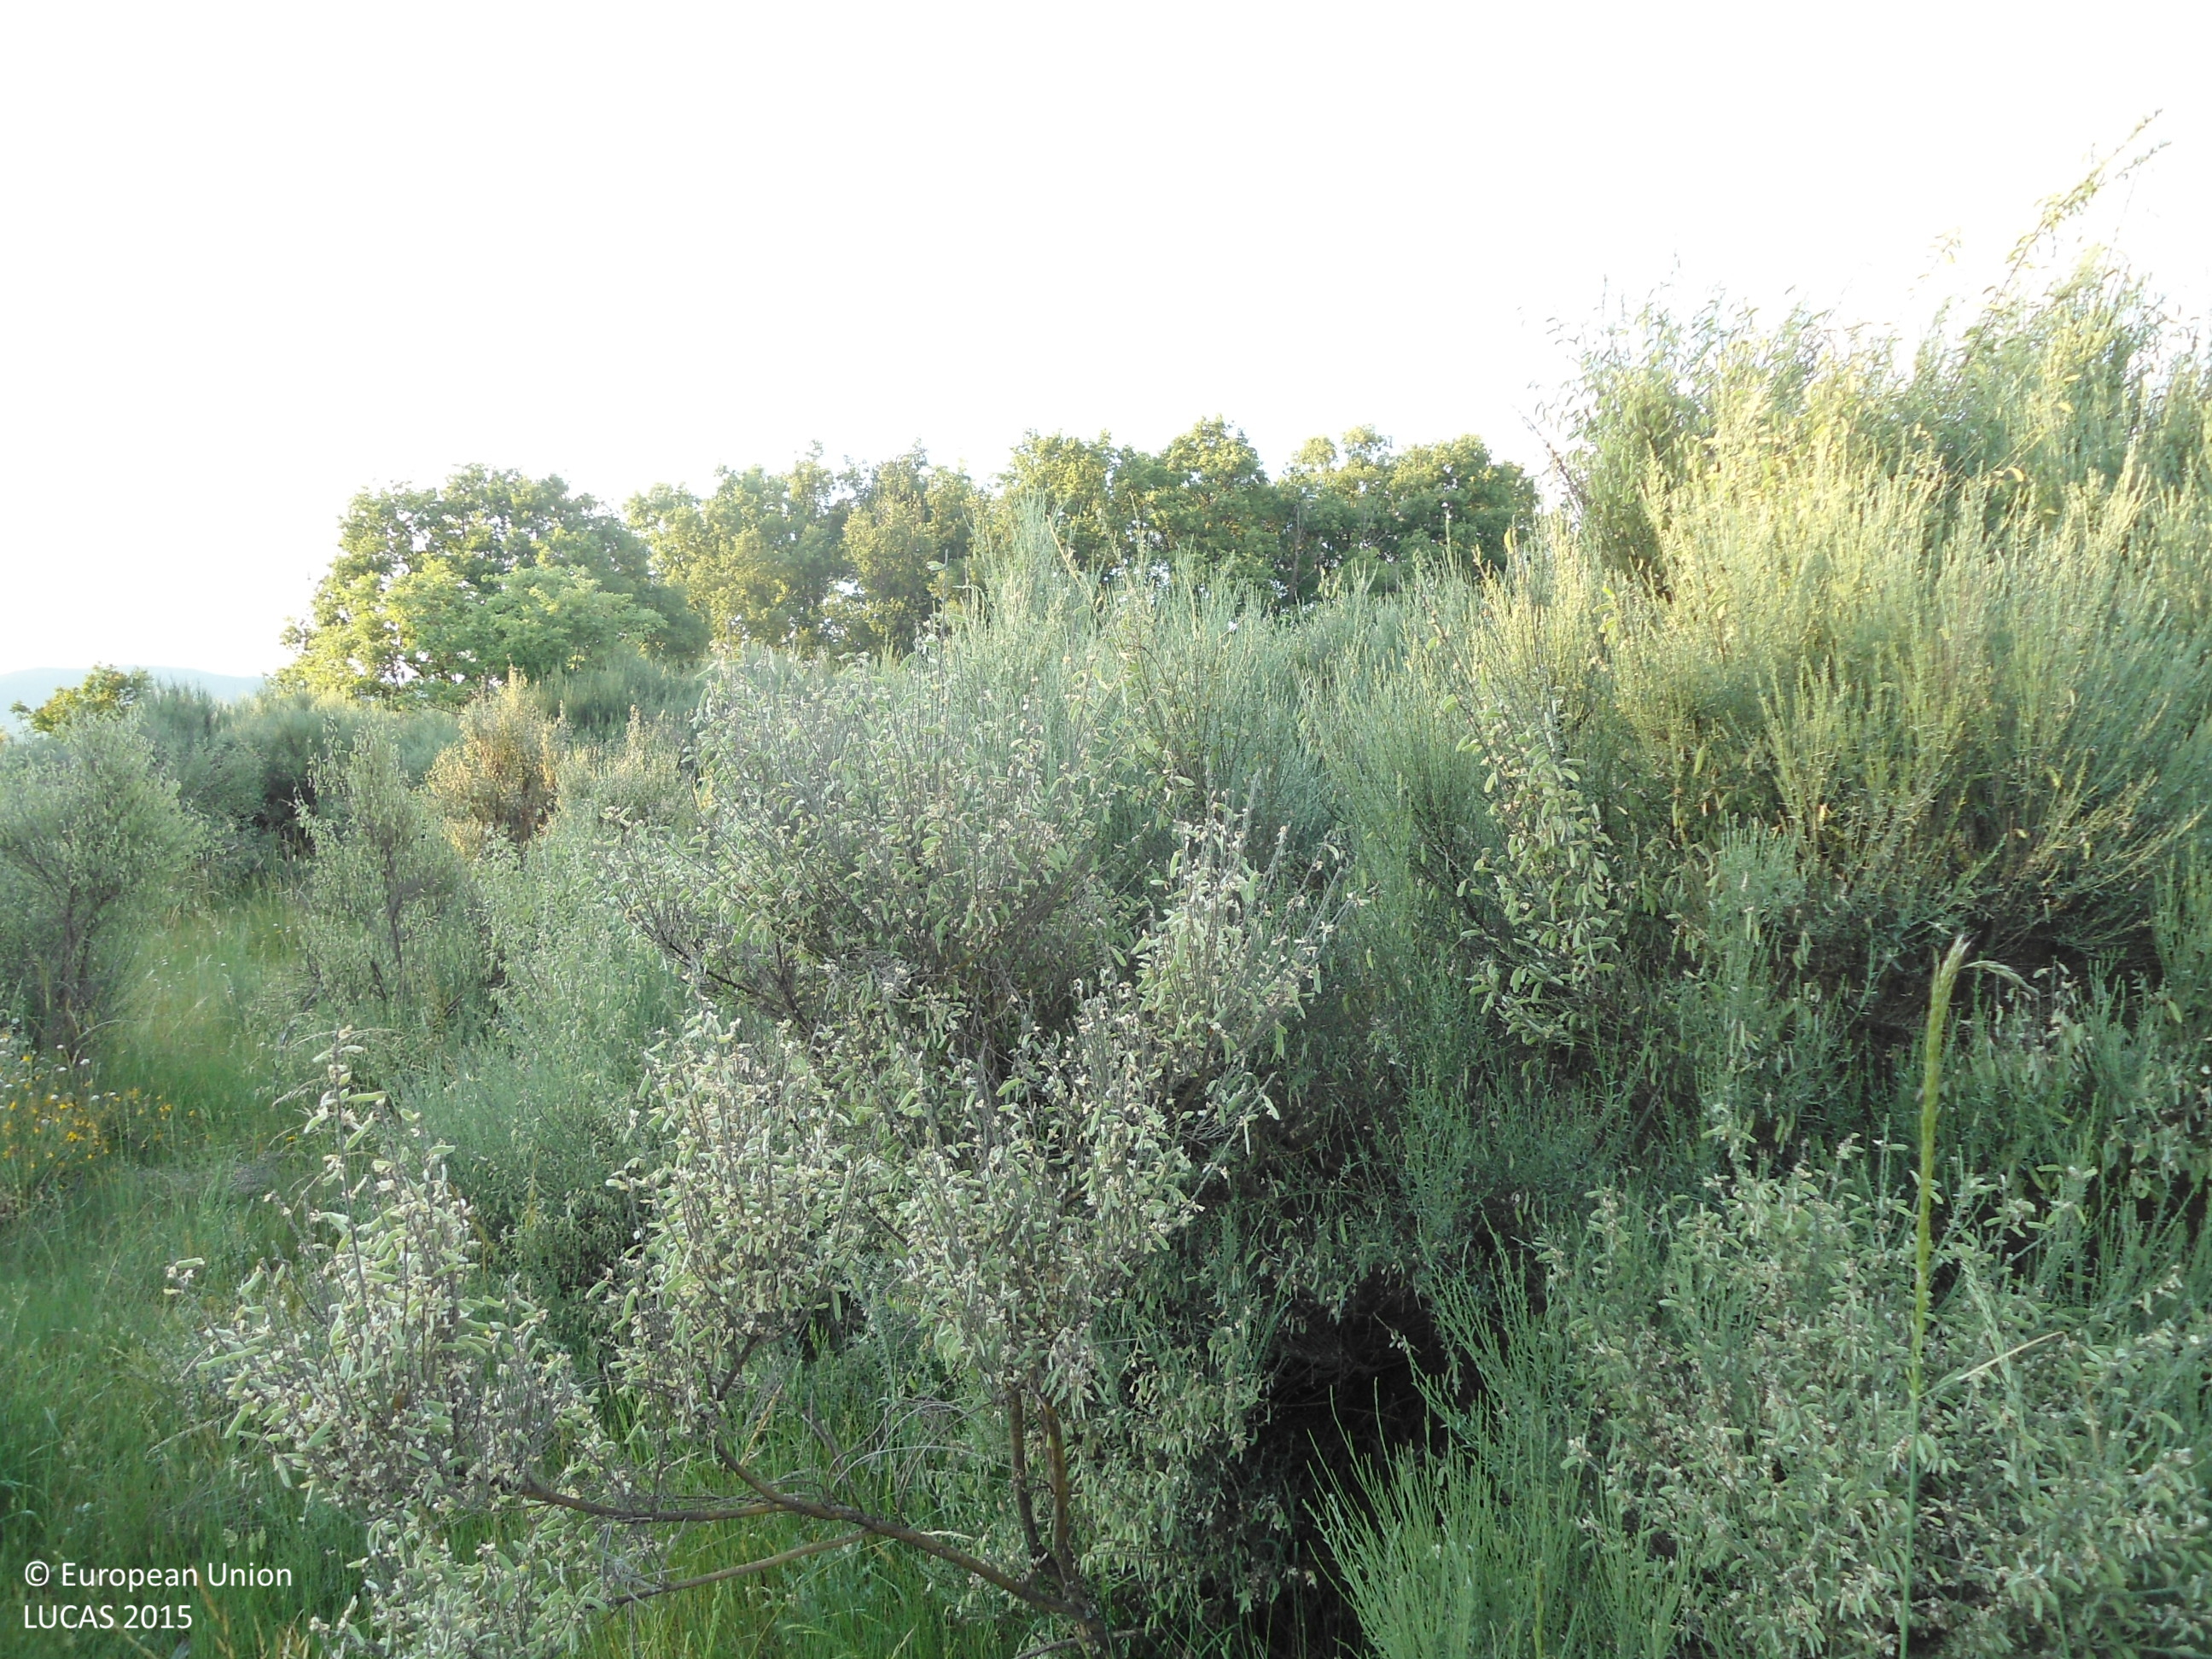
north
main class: Shrubland
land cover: Shrubland without tree cover
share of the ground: > 75 %
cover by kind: shrubs 80 %, herbaceous plants 20 %
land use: Semi-natural and natural areas not in use
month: June
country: ES
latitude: 42.0590
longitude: -6.4098
